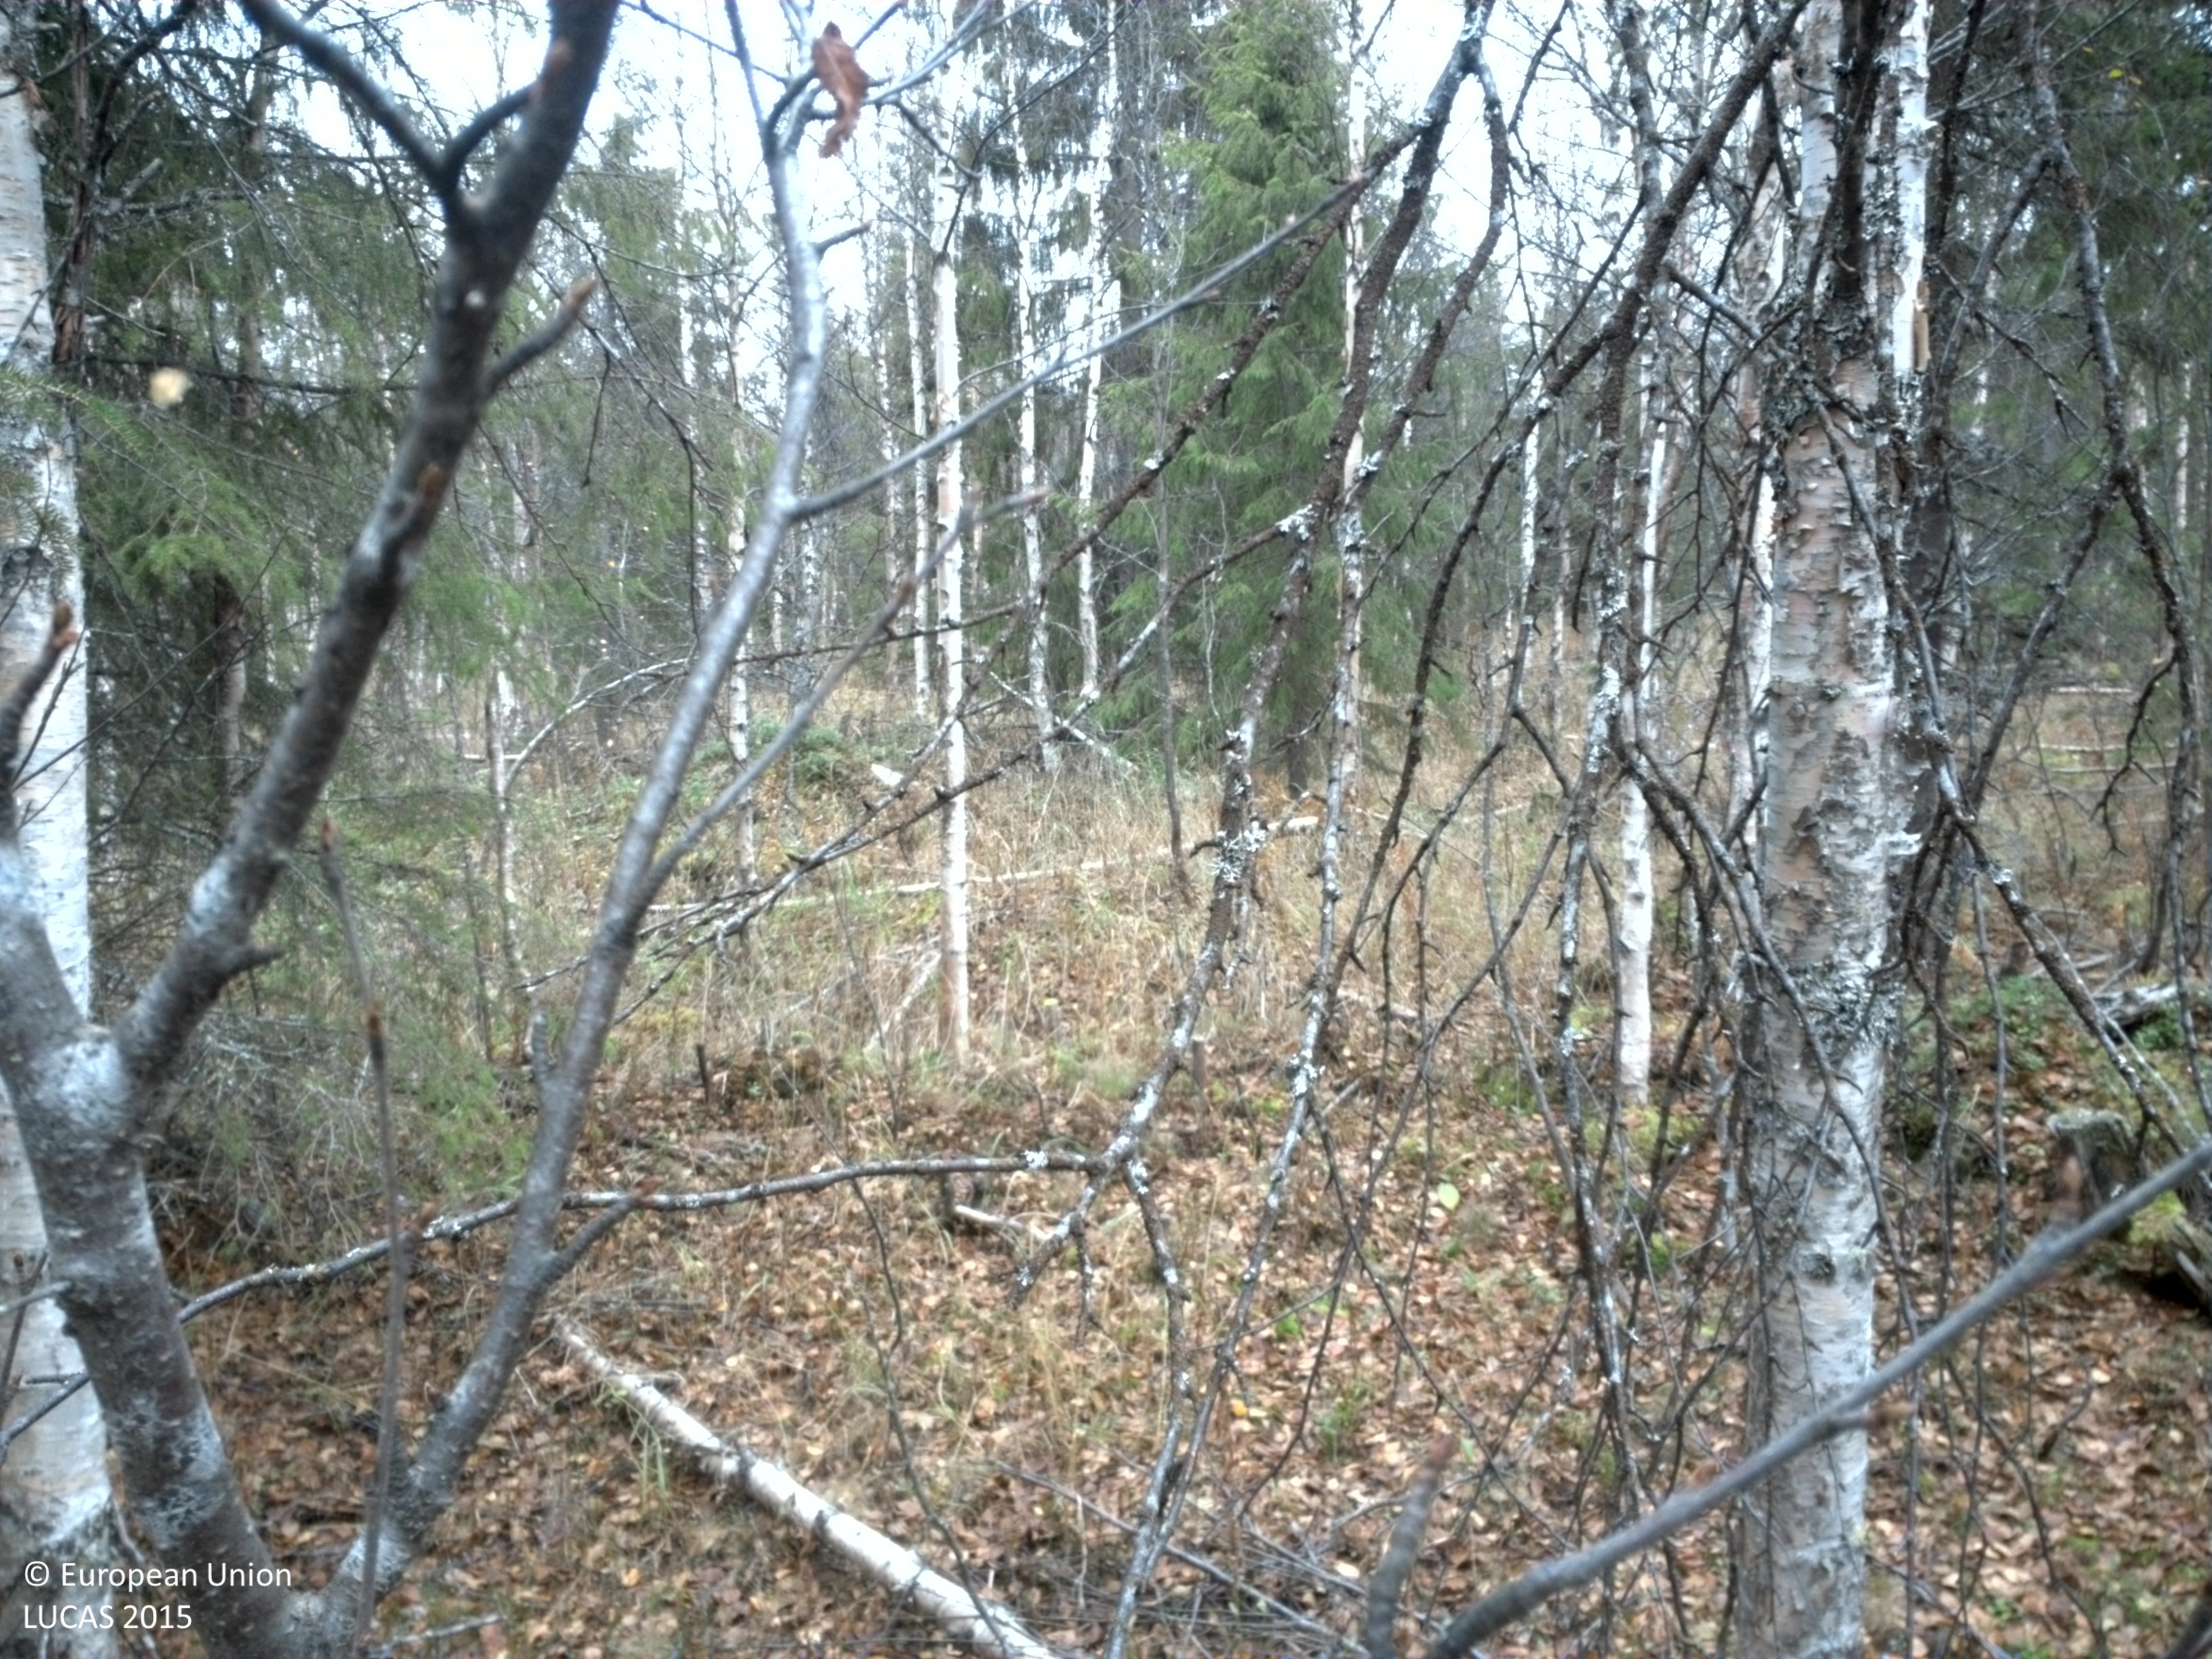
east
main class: Woodland
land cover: Spruce dominated mixed woodland
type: boreal forest
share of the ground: 50 - 75 %
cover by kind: broadleaved forest trees 35 %, unconsolidated bare surface 20 %, coniferous forest trees 15 %, herbaceous plants 15 %, shrubs 10 %, lichens and mosses 5 %
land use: Forestry
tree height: > 5 m
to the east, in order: Spruce dominated mixed woodland; Ditches and canals; Spruce dominated mixed woodland; Other mixed woodland; Ditches and canals; Other mixed woodland; Pine dominated mixed woodland; Broadleaved woodland; Pine dominated mixed woodland; Spruce dominated mixed woodland; Ditches and canals; Spruce dominated mixed woodland
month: October
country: SE
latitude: 64.9902
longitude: 16.9385
